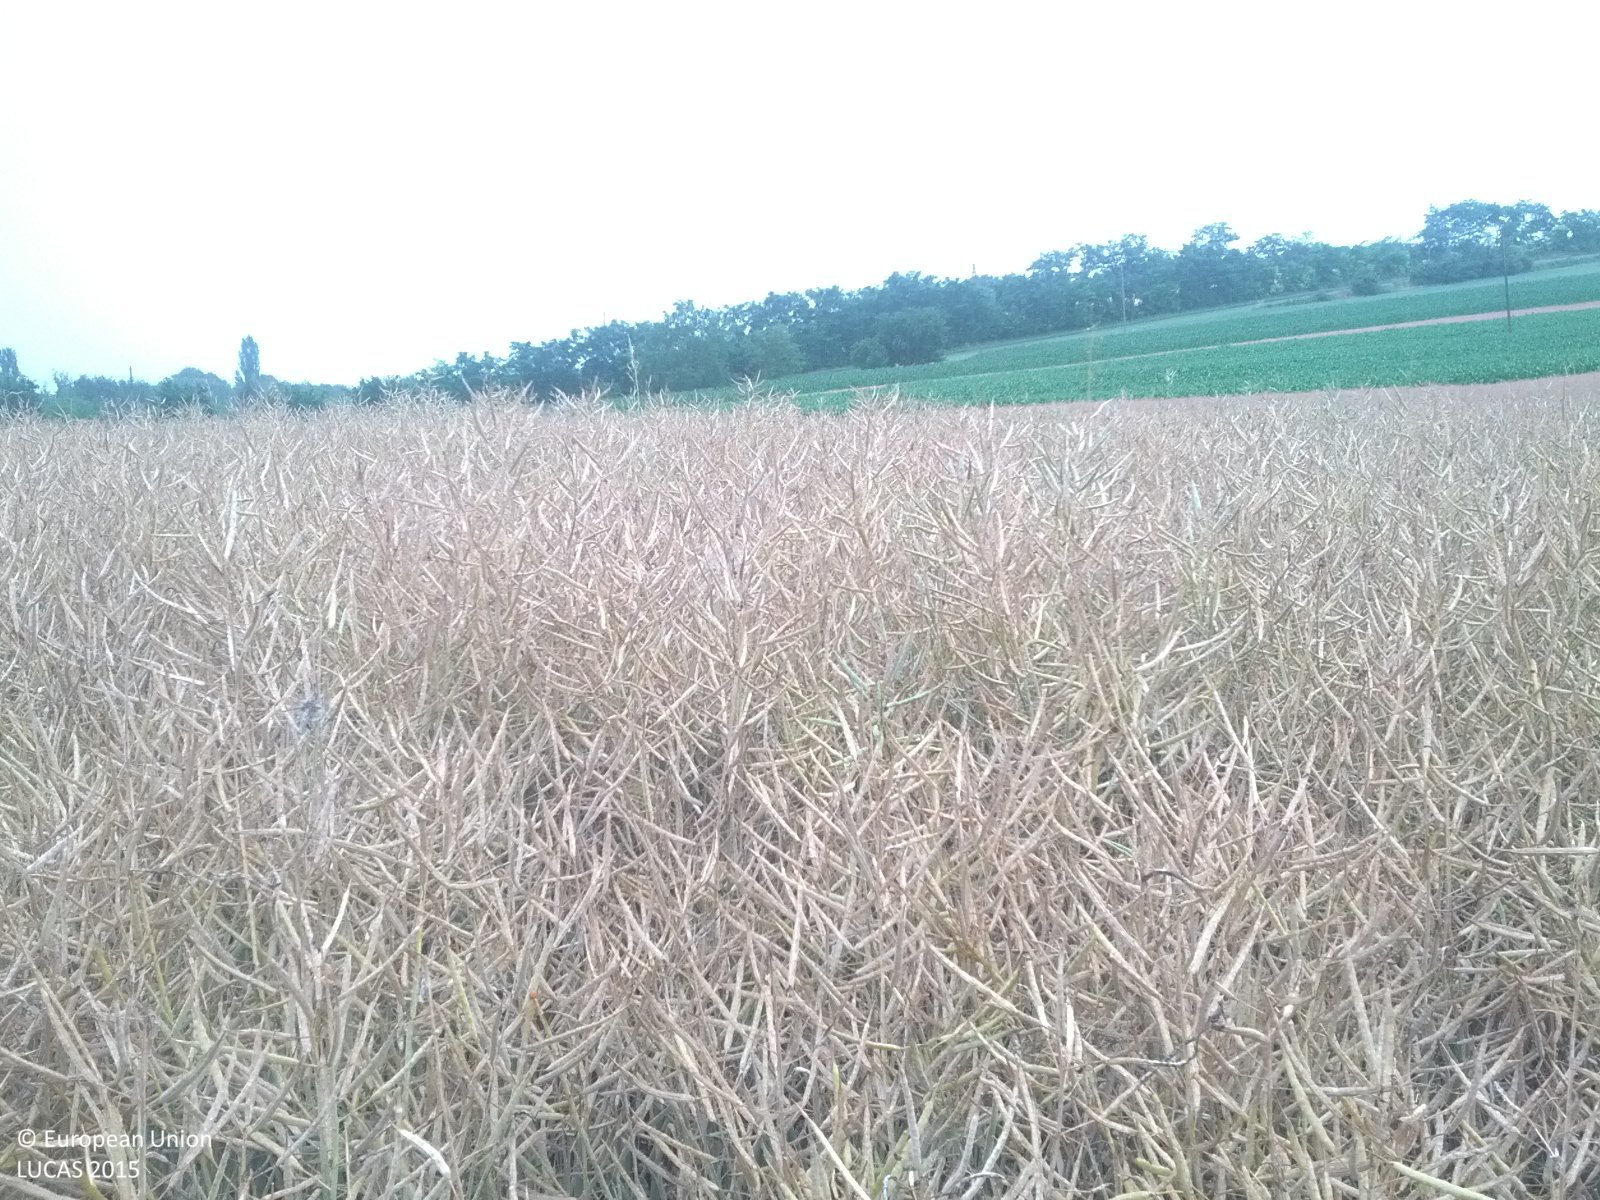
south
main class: Cropland
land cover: Rape and turnip rape
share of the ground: > 75 %
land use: Agriculture (excluding fallow land and kitchen gardens)
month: July
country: AT
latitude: 48.7492
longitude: 16.5758
